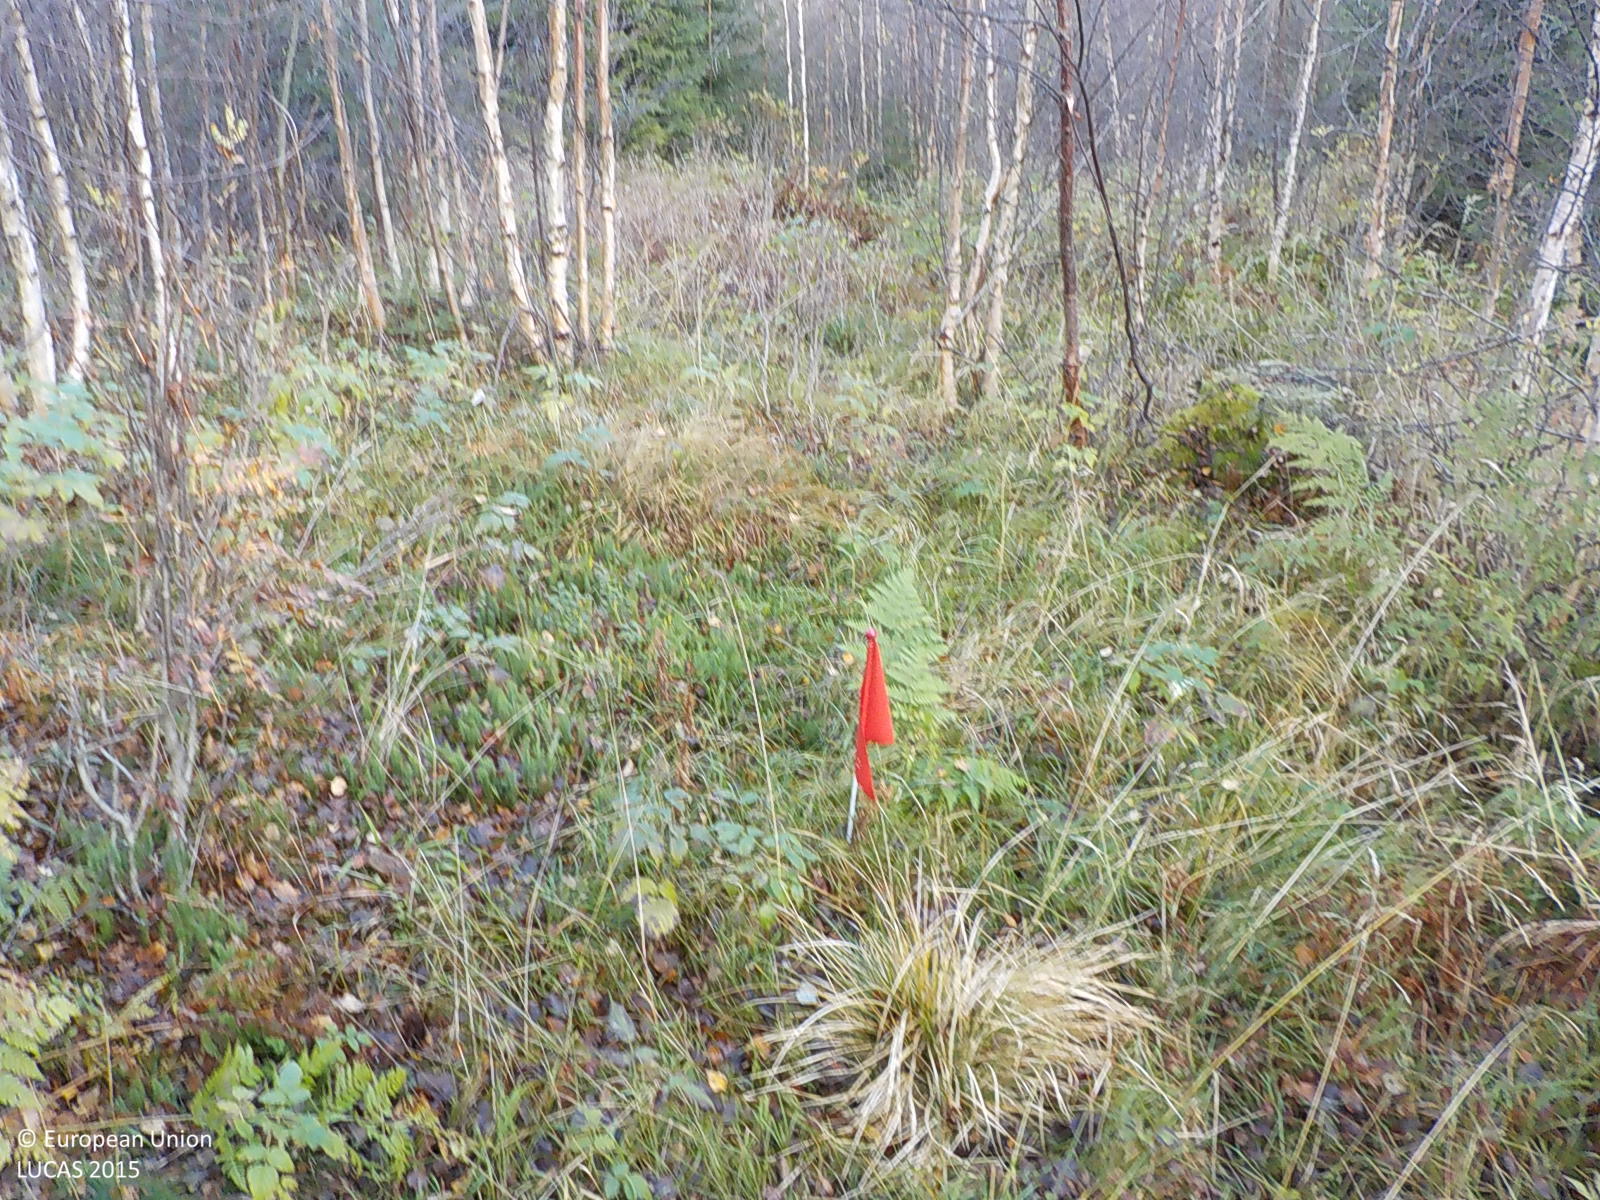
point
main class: Woodland
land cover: Broadleaved woodland
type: mire and swamp forests
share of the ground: 50 - 75 %
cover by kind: broadleaved forest trees 65 %, herbaceous plants 20 %, coniferous forest trees 10 %, lichens and mosses 5 %
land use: Forestry
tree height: > 5 m
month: October
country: SE
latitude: 62.9670
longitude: 18.2423
